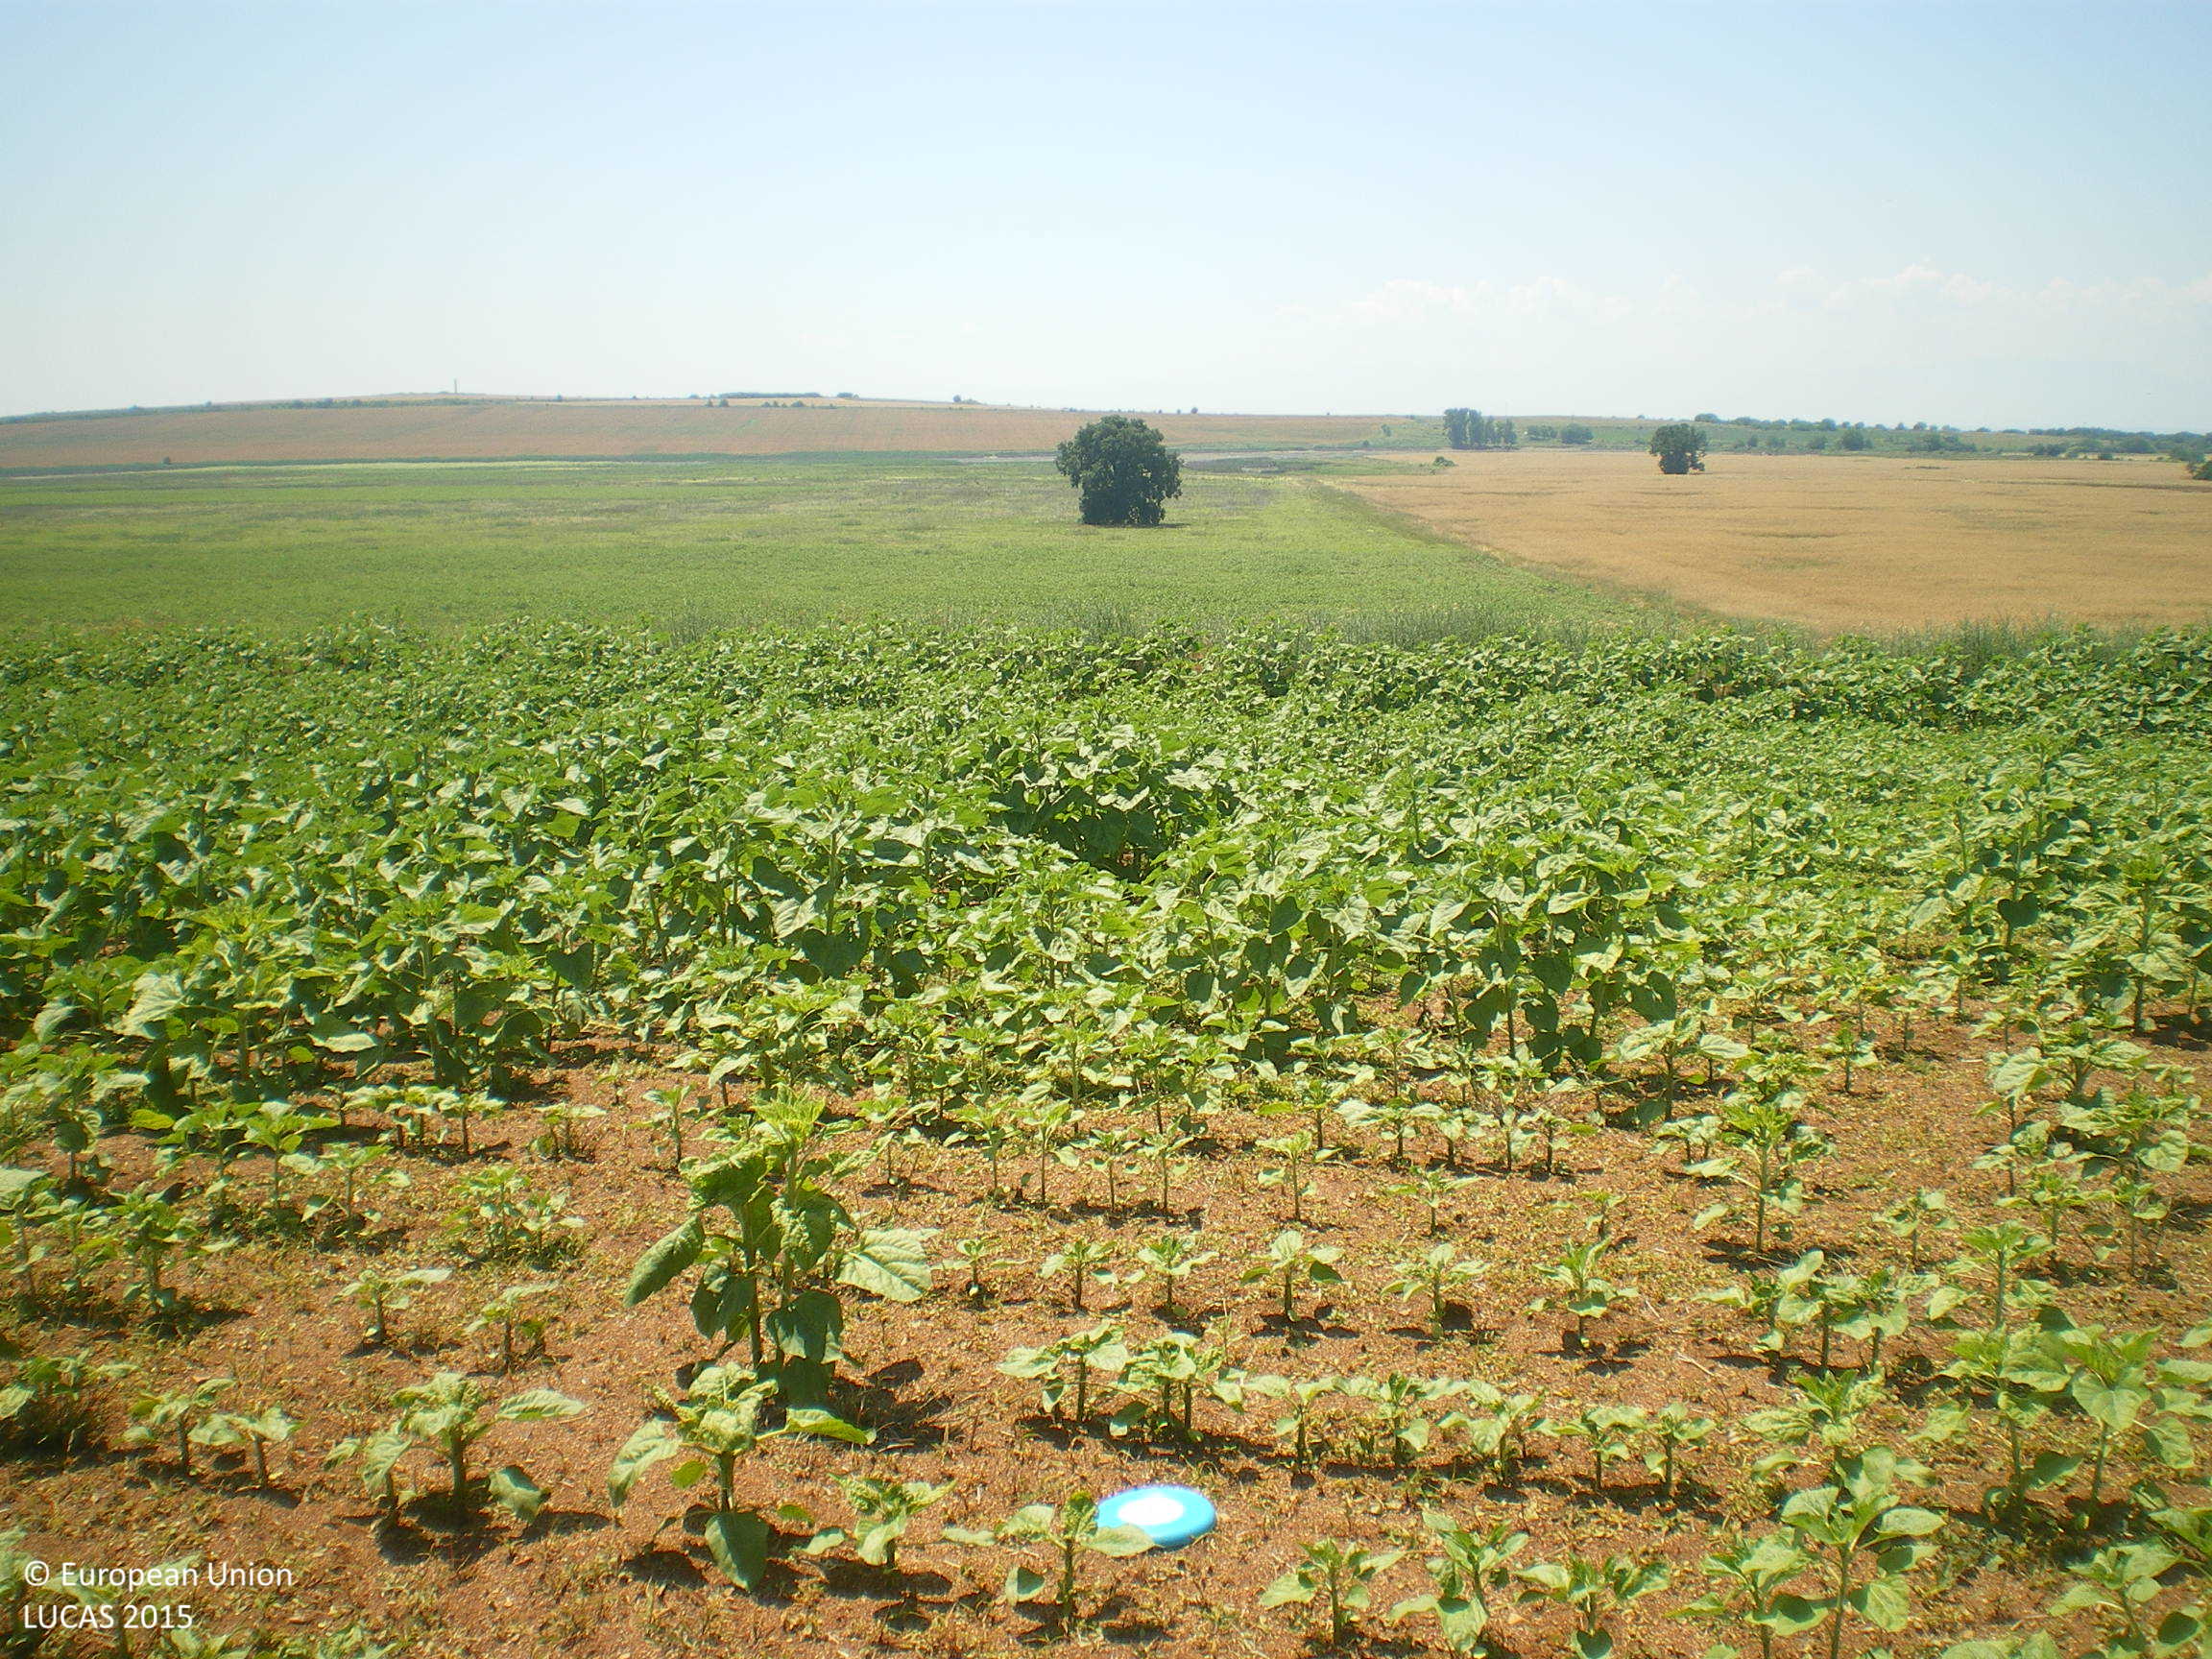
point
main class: Cropland
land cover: Sunflower
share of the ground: 50 - 75 %
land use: Agriculture (excluding fallow land and kitchen gardens)
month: June
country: BG
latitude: 42.2974
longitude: 25.1374
